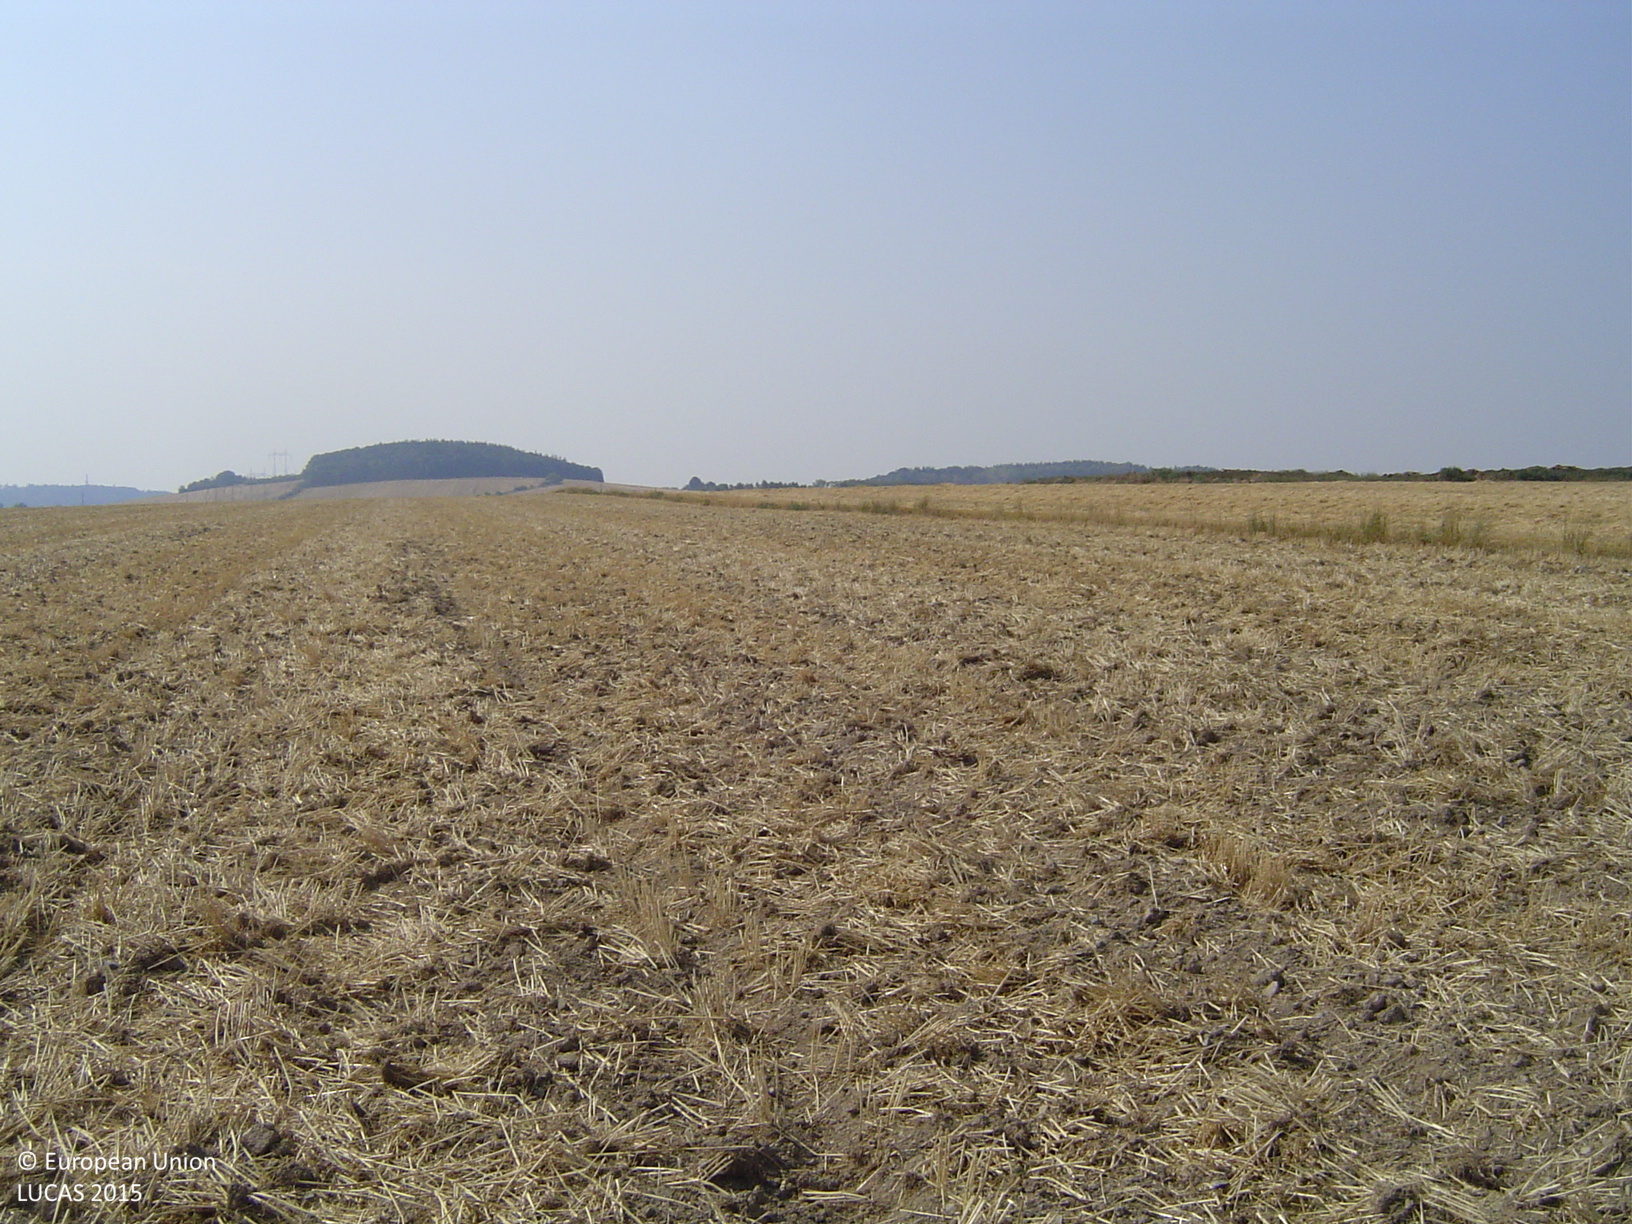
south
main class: Cropland
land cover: Common wheat
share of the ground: 50 - 75 %
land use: Agriculture (excluding fallow land and kitchen gardens)
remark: Harvested field
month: August
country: CZ
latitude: 50.0388
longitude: 14.0920
